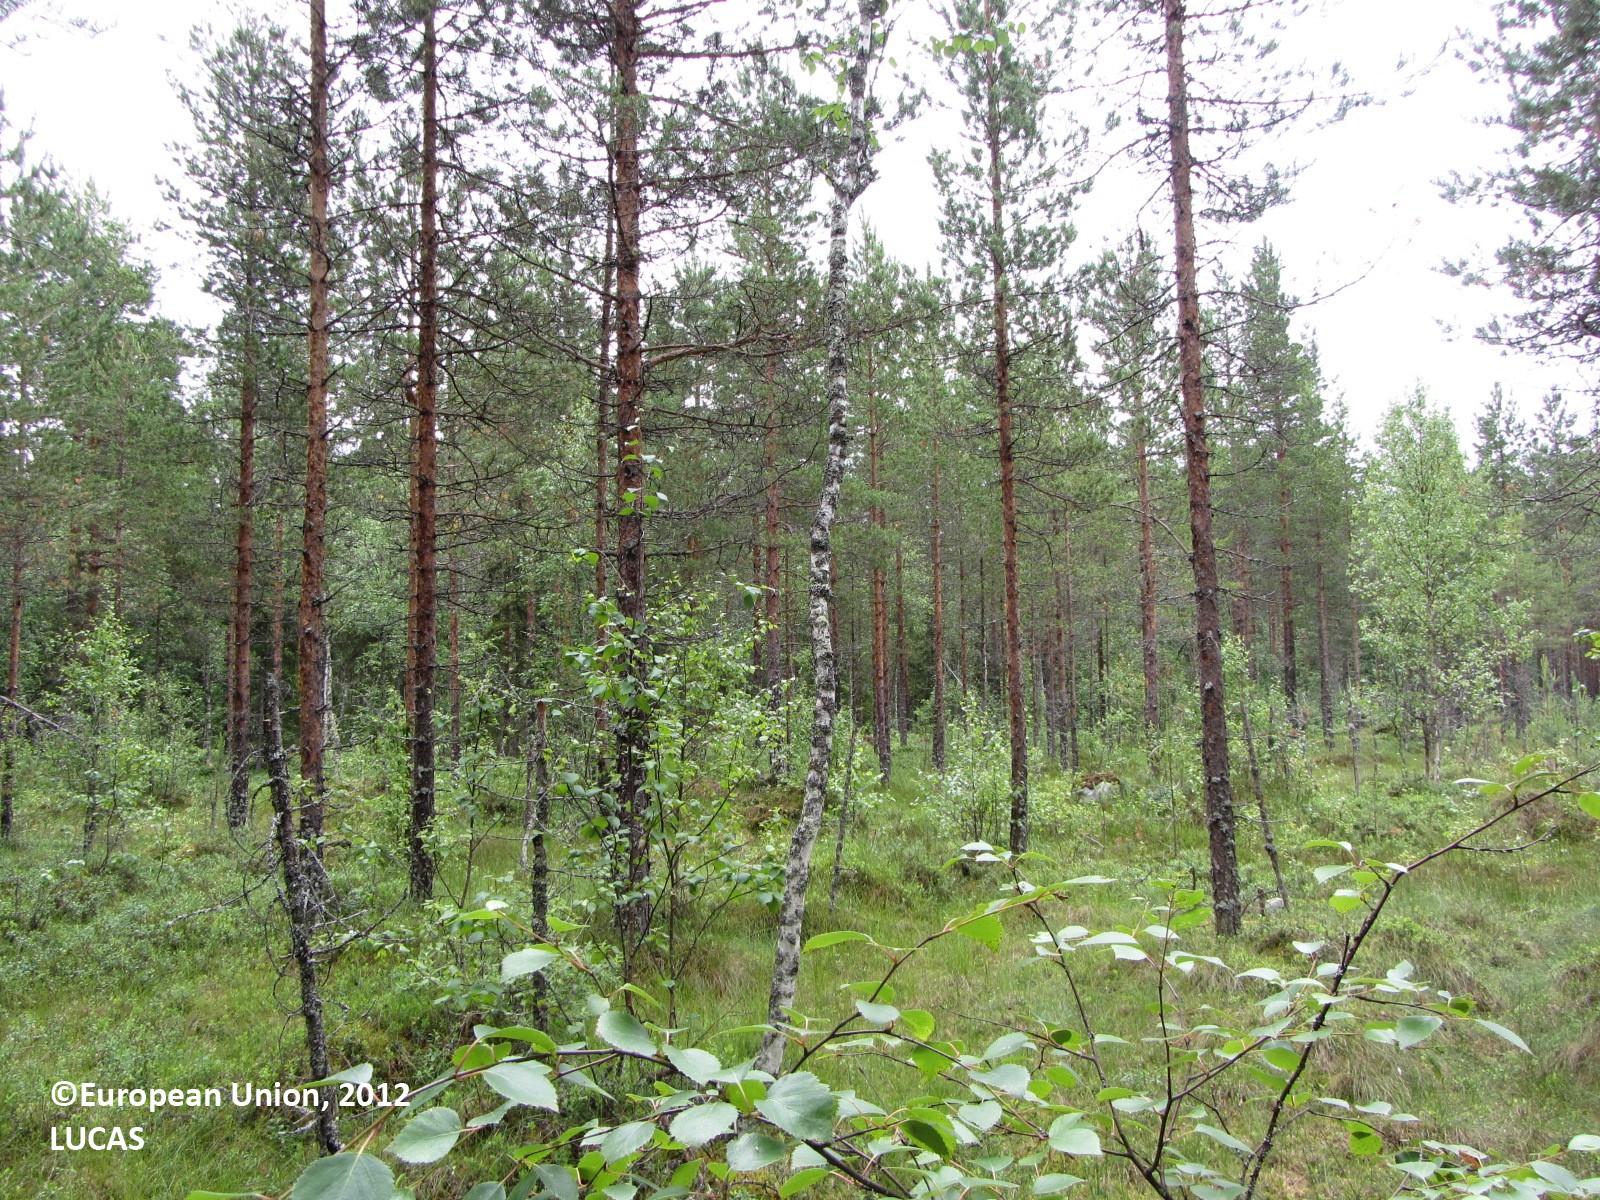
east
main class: Woodland
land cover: Pine dominated coniferous woodland
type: boreal forest
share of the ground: 50 - 75 %
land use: Forestry
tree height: > 5 m
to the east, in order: Pine dominated coniferous woodland; Ditches and canals; Pine dominated mixed woodland; Ditches and canals; Spruce dominated coniferous woodland; Ditches and canals; Grassland without tree/shrub cover; Spontaneously vegetated surfaces; Ditches and canals; Spontaneously vegetated surfaces; Grassland without tree/shrub cover; Ditches and canals; Abandoned hedges; Grass margins; Paved roads, cycling and walking lanes; Grass margins; Ditches and canals; Grass margins; Temporary grasslands; Ditches and canals; Temporary grasslands; Lines of trees; Spontaneously vegetated surfaces
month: July
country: FI
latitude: 63.8577
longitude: 25.6216
